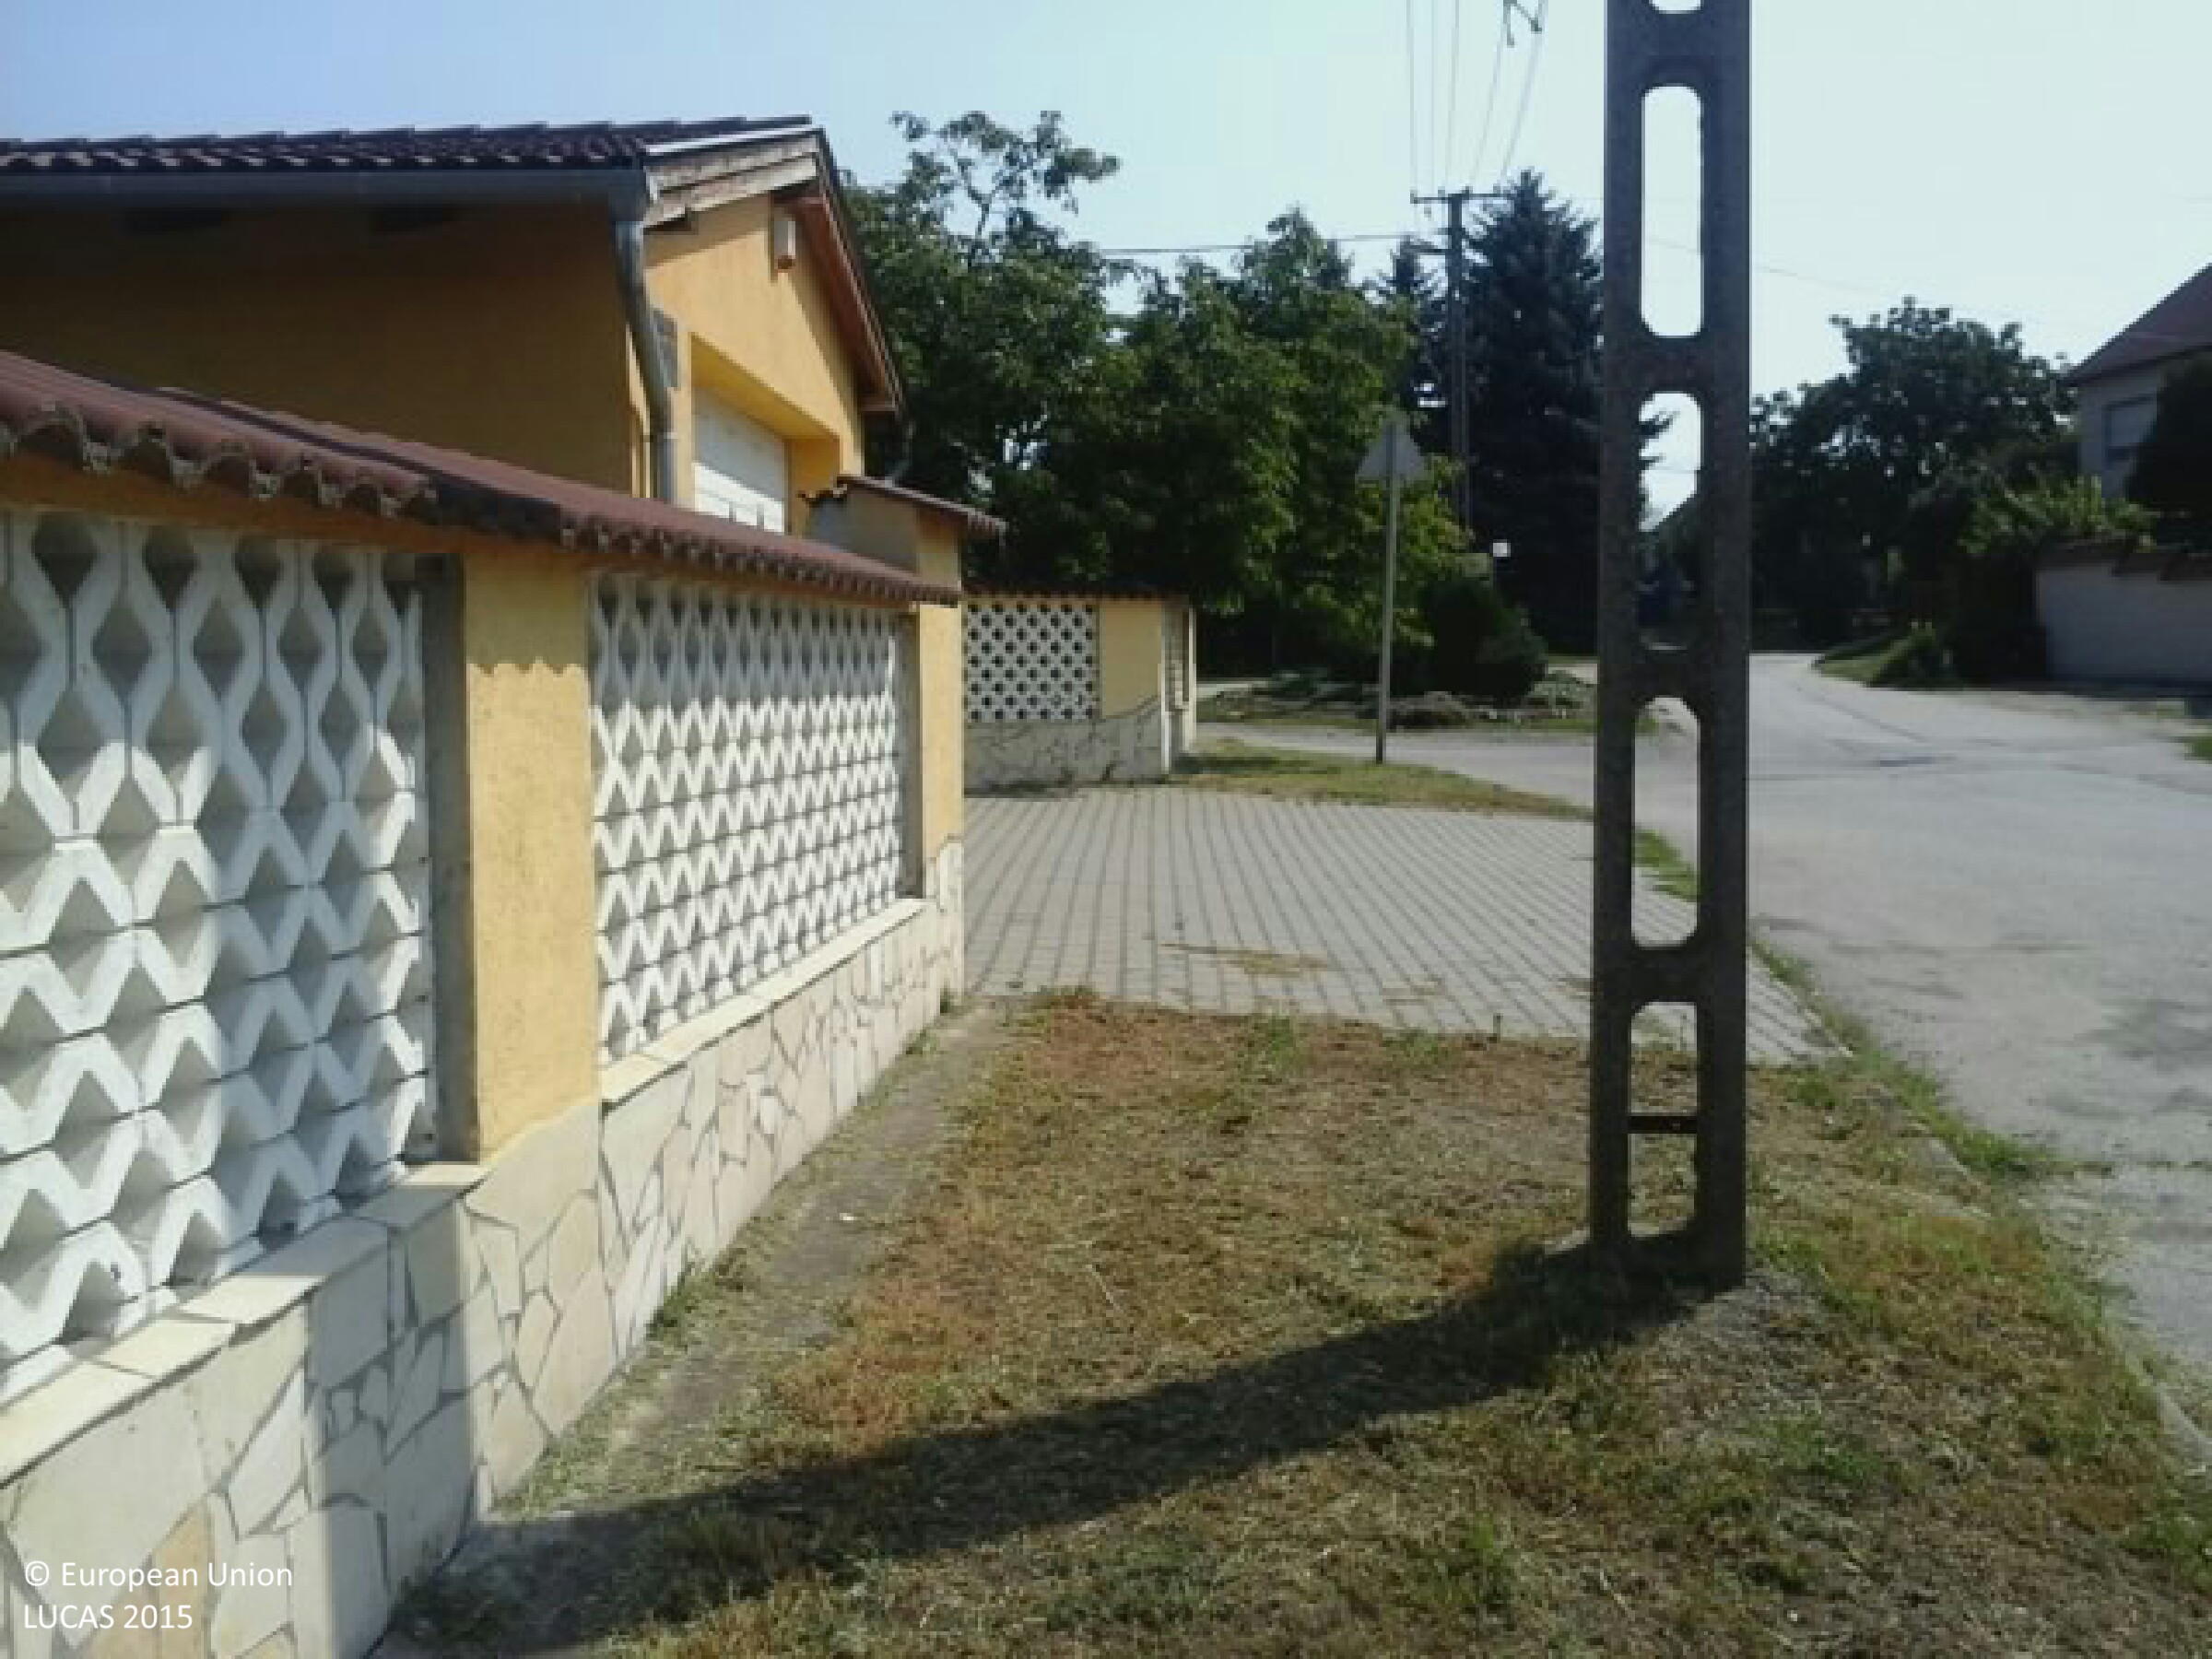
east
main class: Grassland
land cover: Grassland with sparse tree/shrub cover
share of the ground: > 75 %
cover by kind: herbaceous plants 85 %, shrubs 10 %, broadleaved forest trees 5 %
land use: Residential
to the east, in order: Grassland with sparse tree/shrub cover; Artificial constructions in urban areas
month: August
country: HU
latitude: 46.9011
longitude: 18.9279
